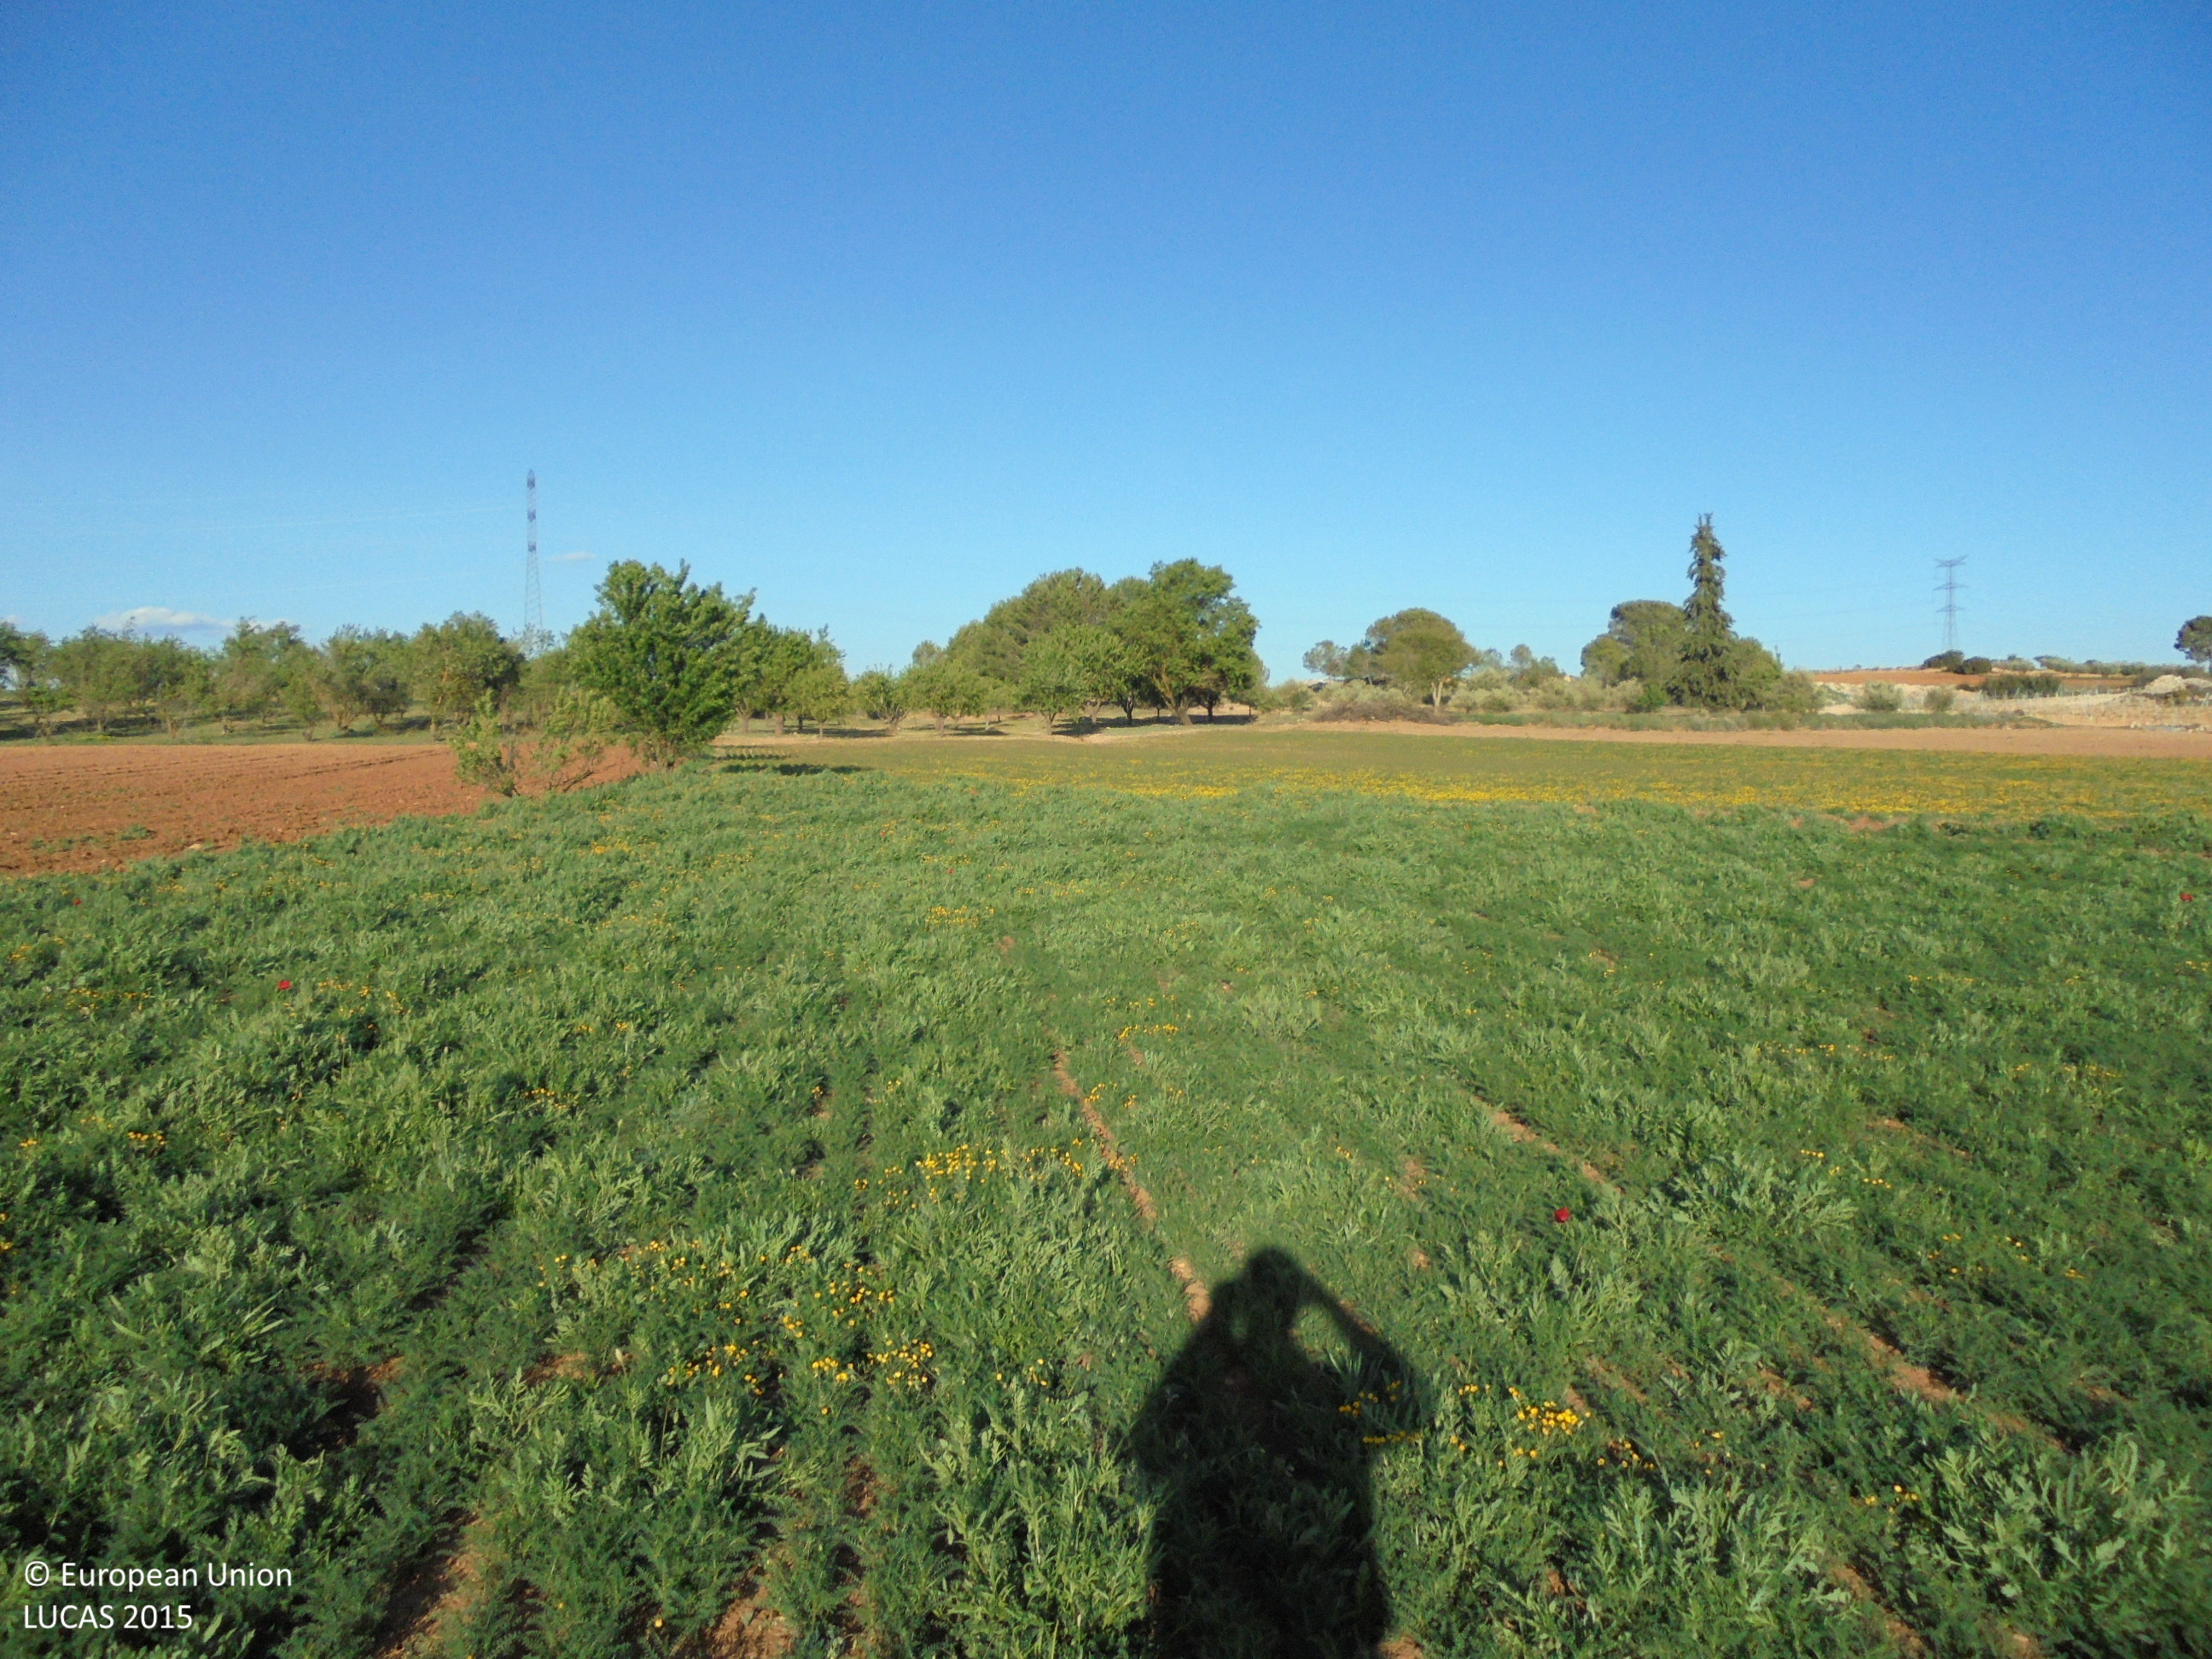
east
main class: Cropland
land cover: Dry pulses
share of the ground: > 75 %
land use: Agriculture (excluding fallow land and kitchen gardens)
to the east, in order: Dry pulses; Grass margins; Dry pulses; Grass margins; Nuts trees; Pine dominated coniferous woodland; Olive groves; Pine dominated coniferous woodland; Tracks; Grass margins; Spontaneously vegetated surfaces
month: April
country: ES
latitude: 39.2615
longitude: -1.7897
